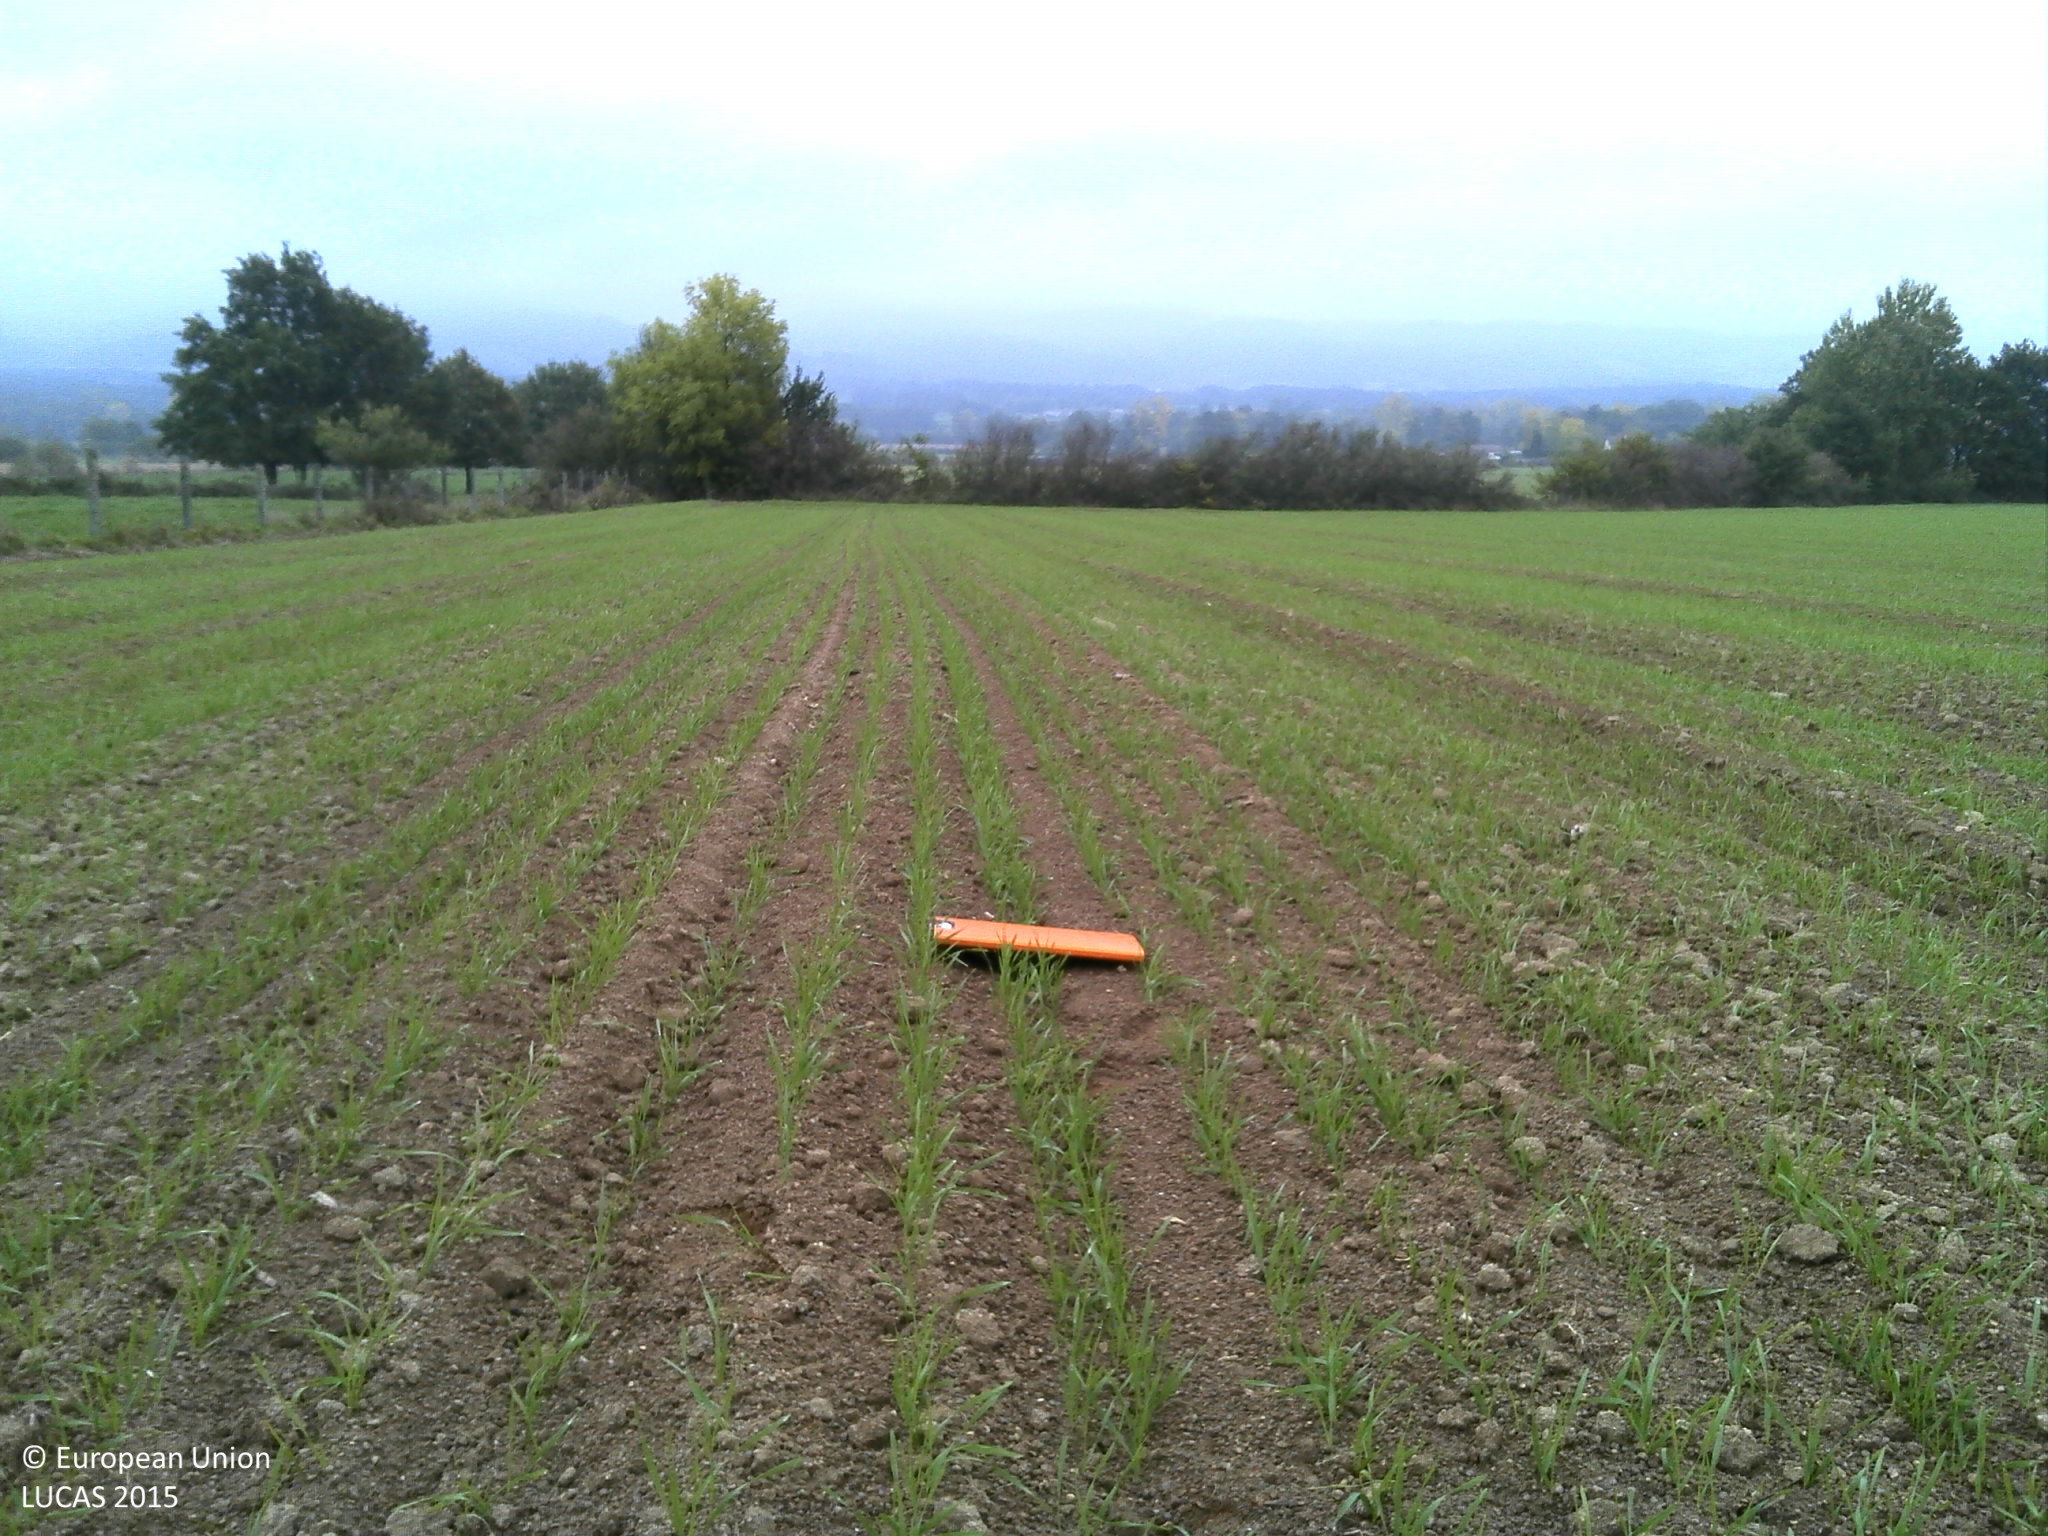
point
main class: Cropland
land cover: Common wheat
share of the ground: 25 - 50 %
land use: Agriculture (excluding fallow land and kitchen gardens)
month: October
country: FR
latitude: 45.4981
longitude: 3.7189
